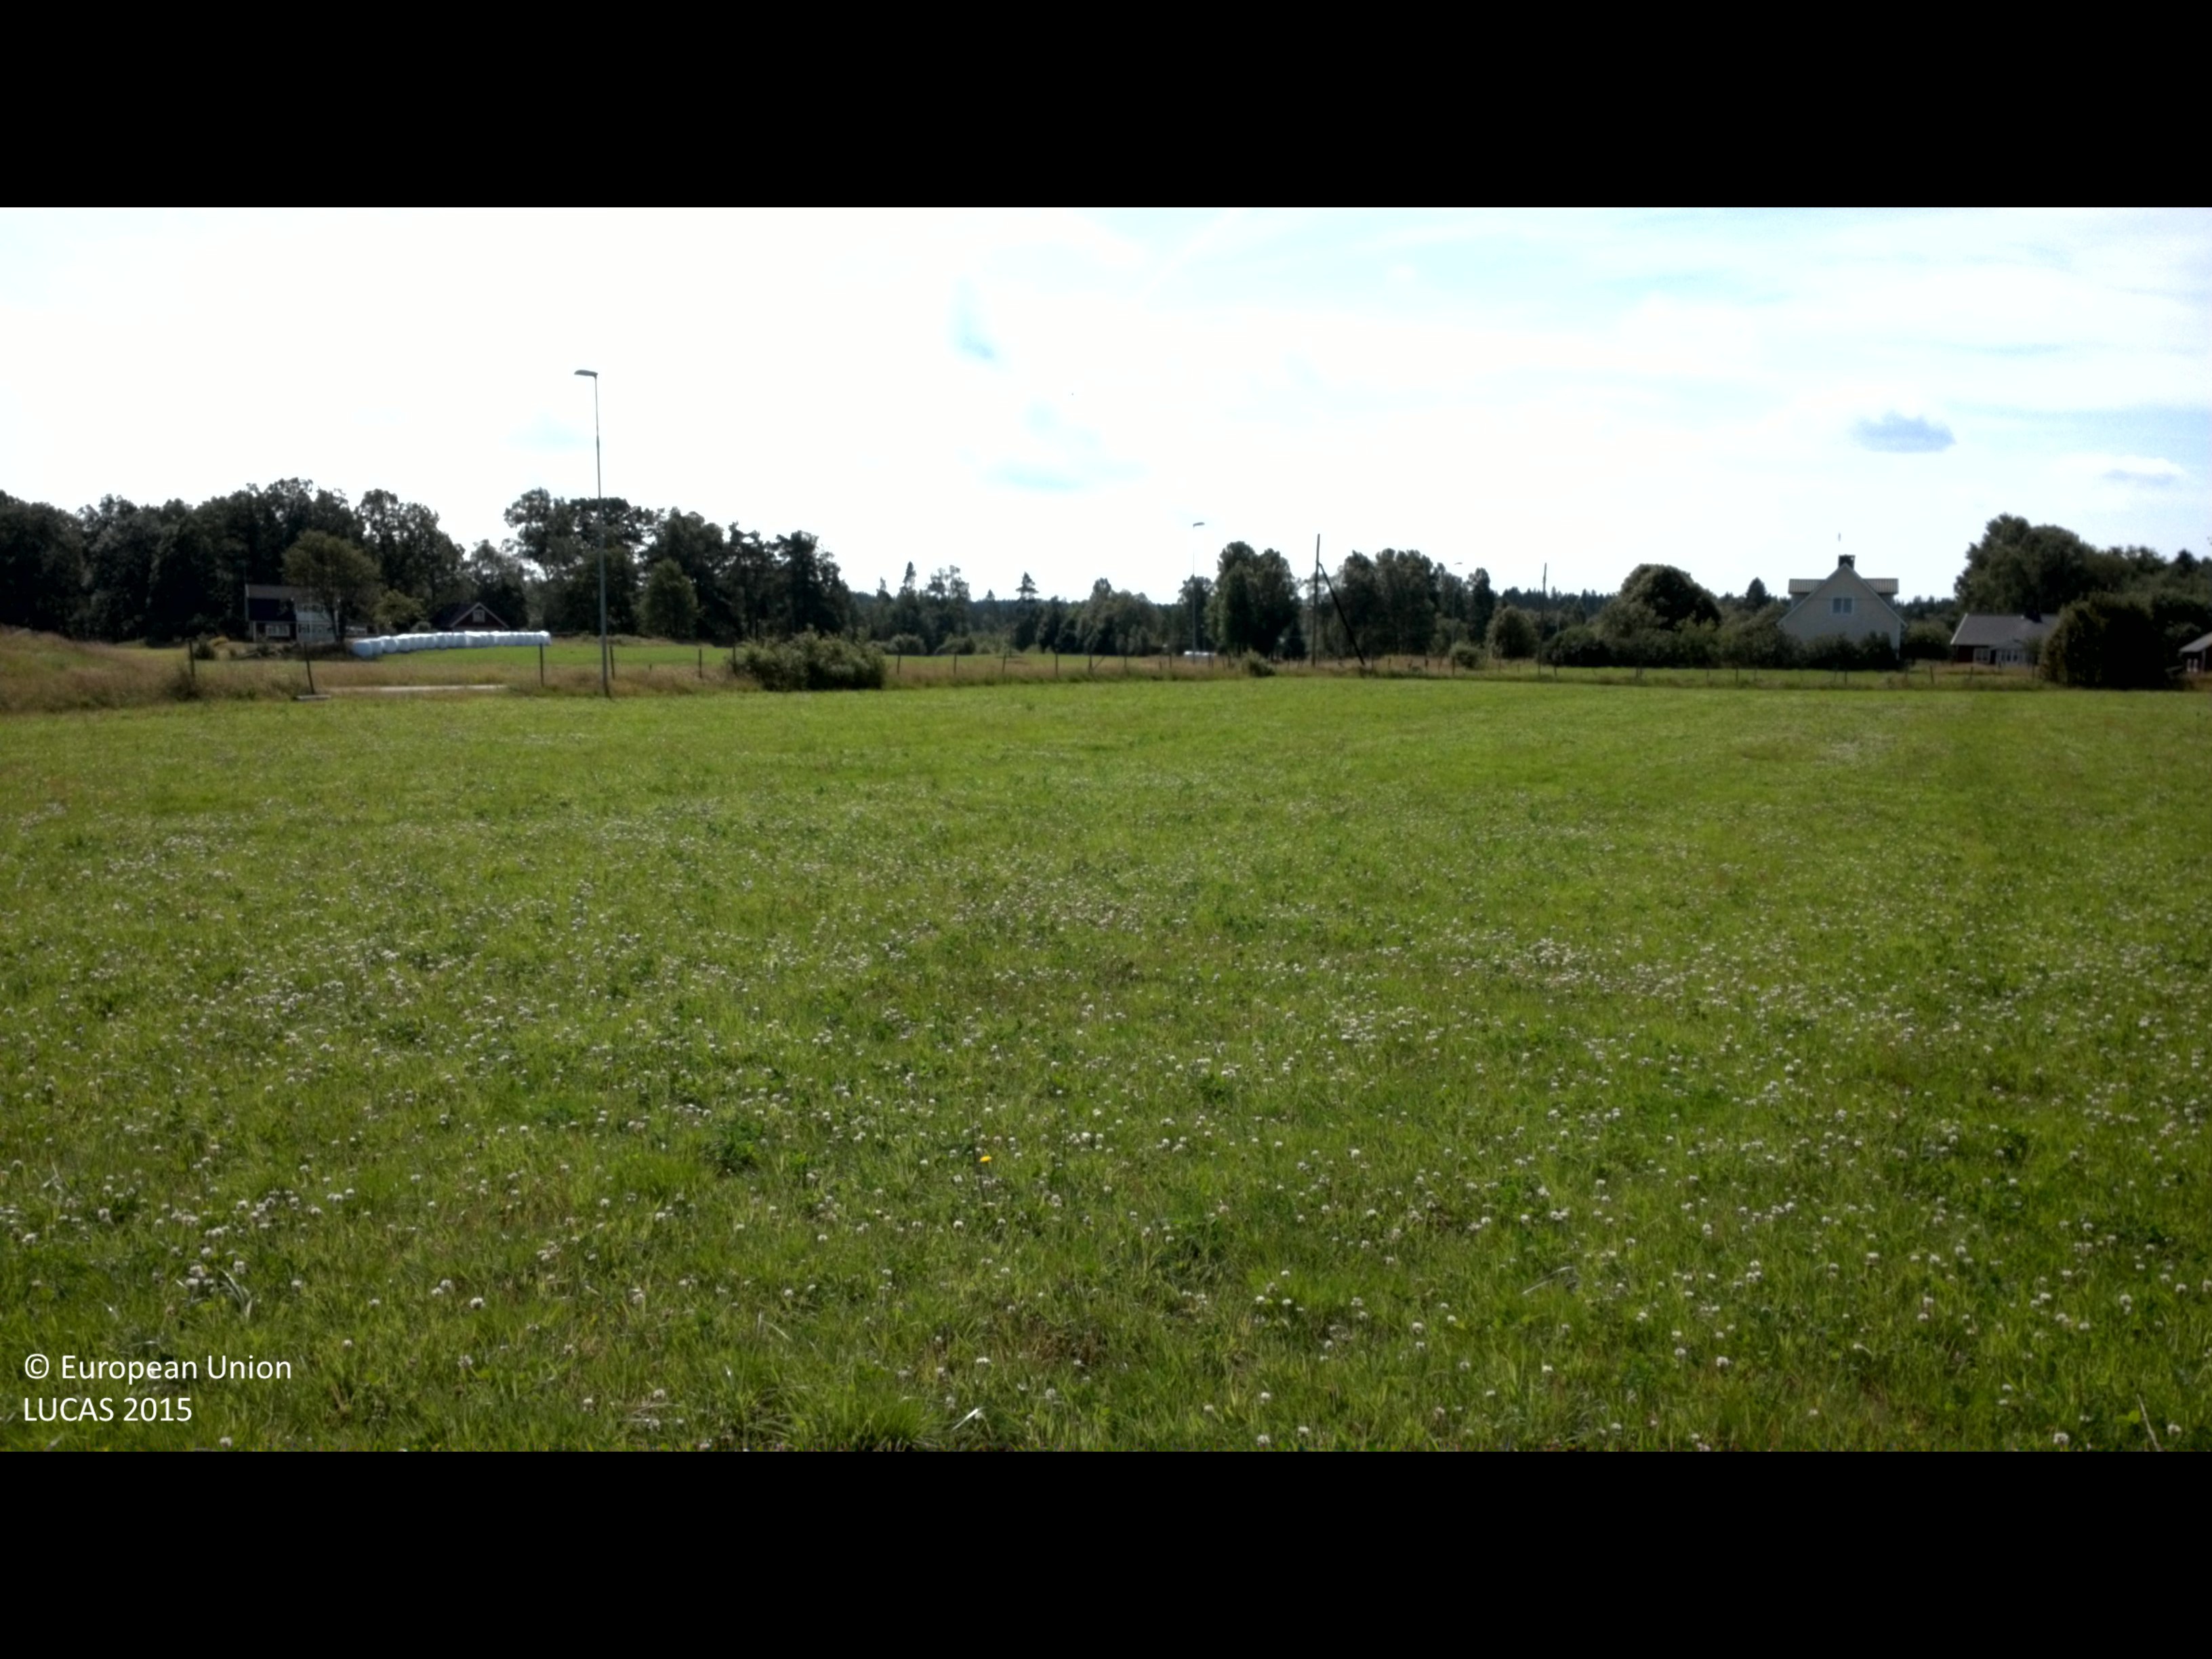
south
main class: Grassland
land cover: Grassland without tree/shrub cover
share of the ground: > 75 %
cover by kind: herbaceous plants 100 %
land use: Agriculture (excluding fallow land and kitchen gardens)
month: August
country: SE
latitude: 56.5809
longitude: 13.8227
